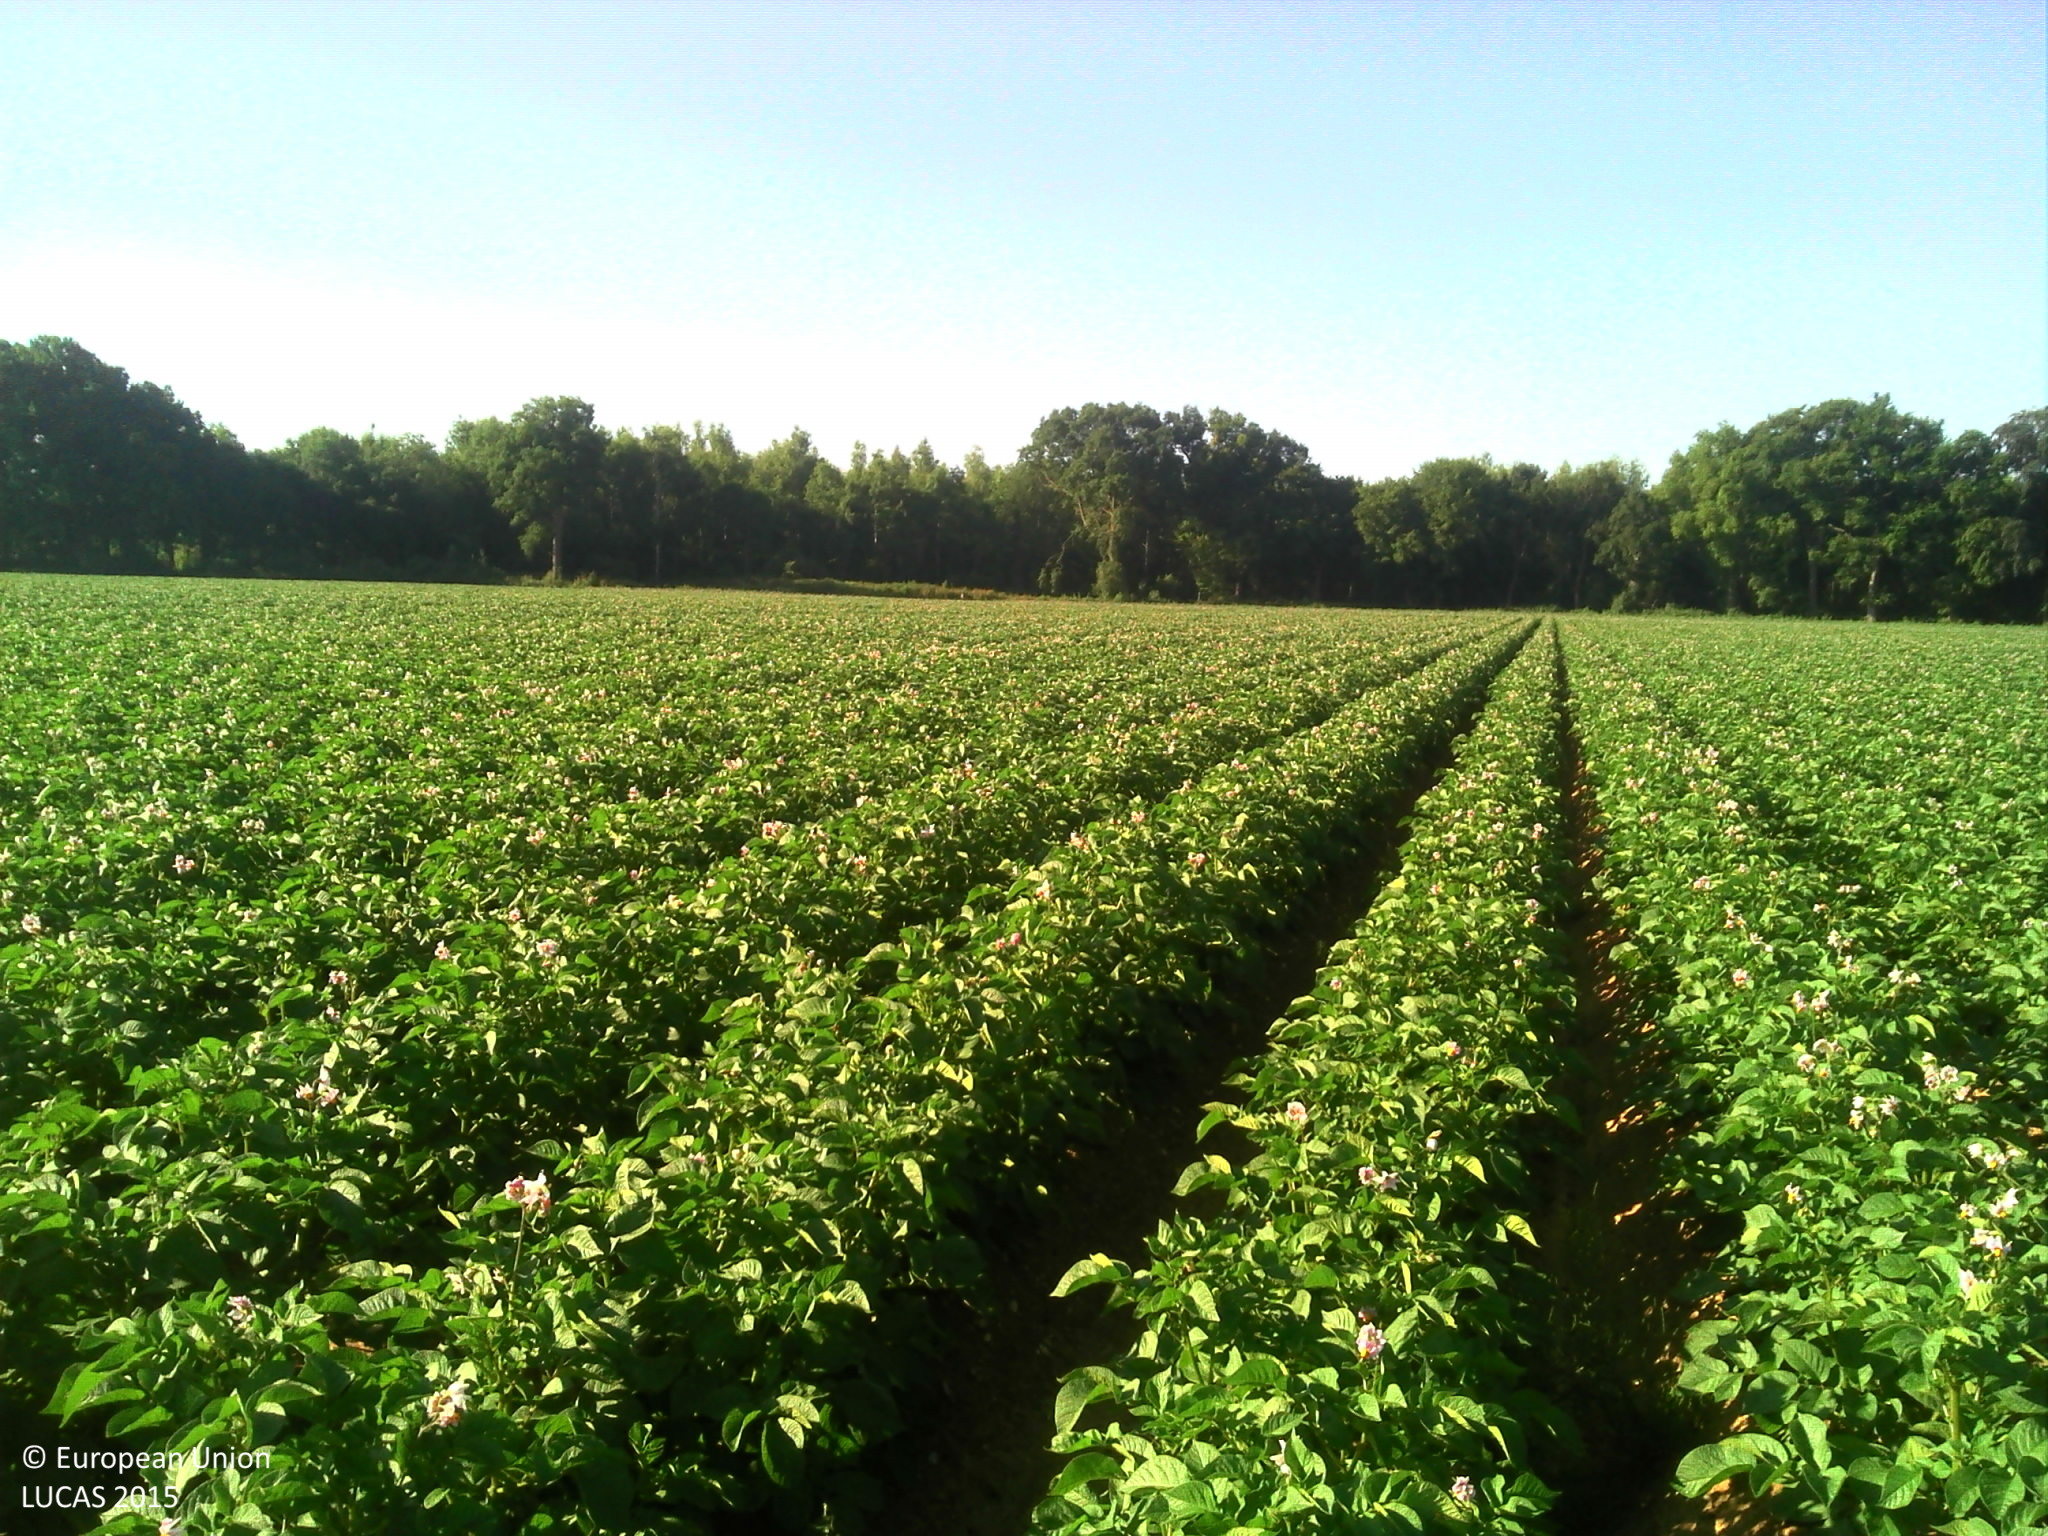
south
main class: Cropland
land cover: Potatoes
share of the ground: > 75 %
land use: Agriculture (excluding fallow land and kitchen gardens)
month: June
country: FR
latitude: 49.8313
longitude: 2.2706
